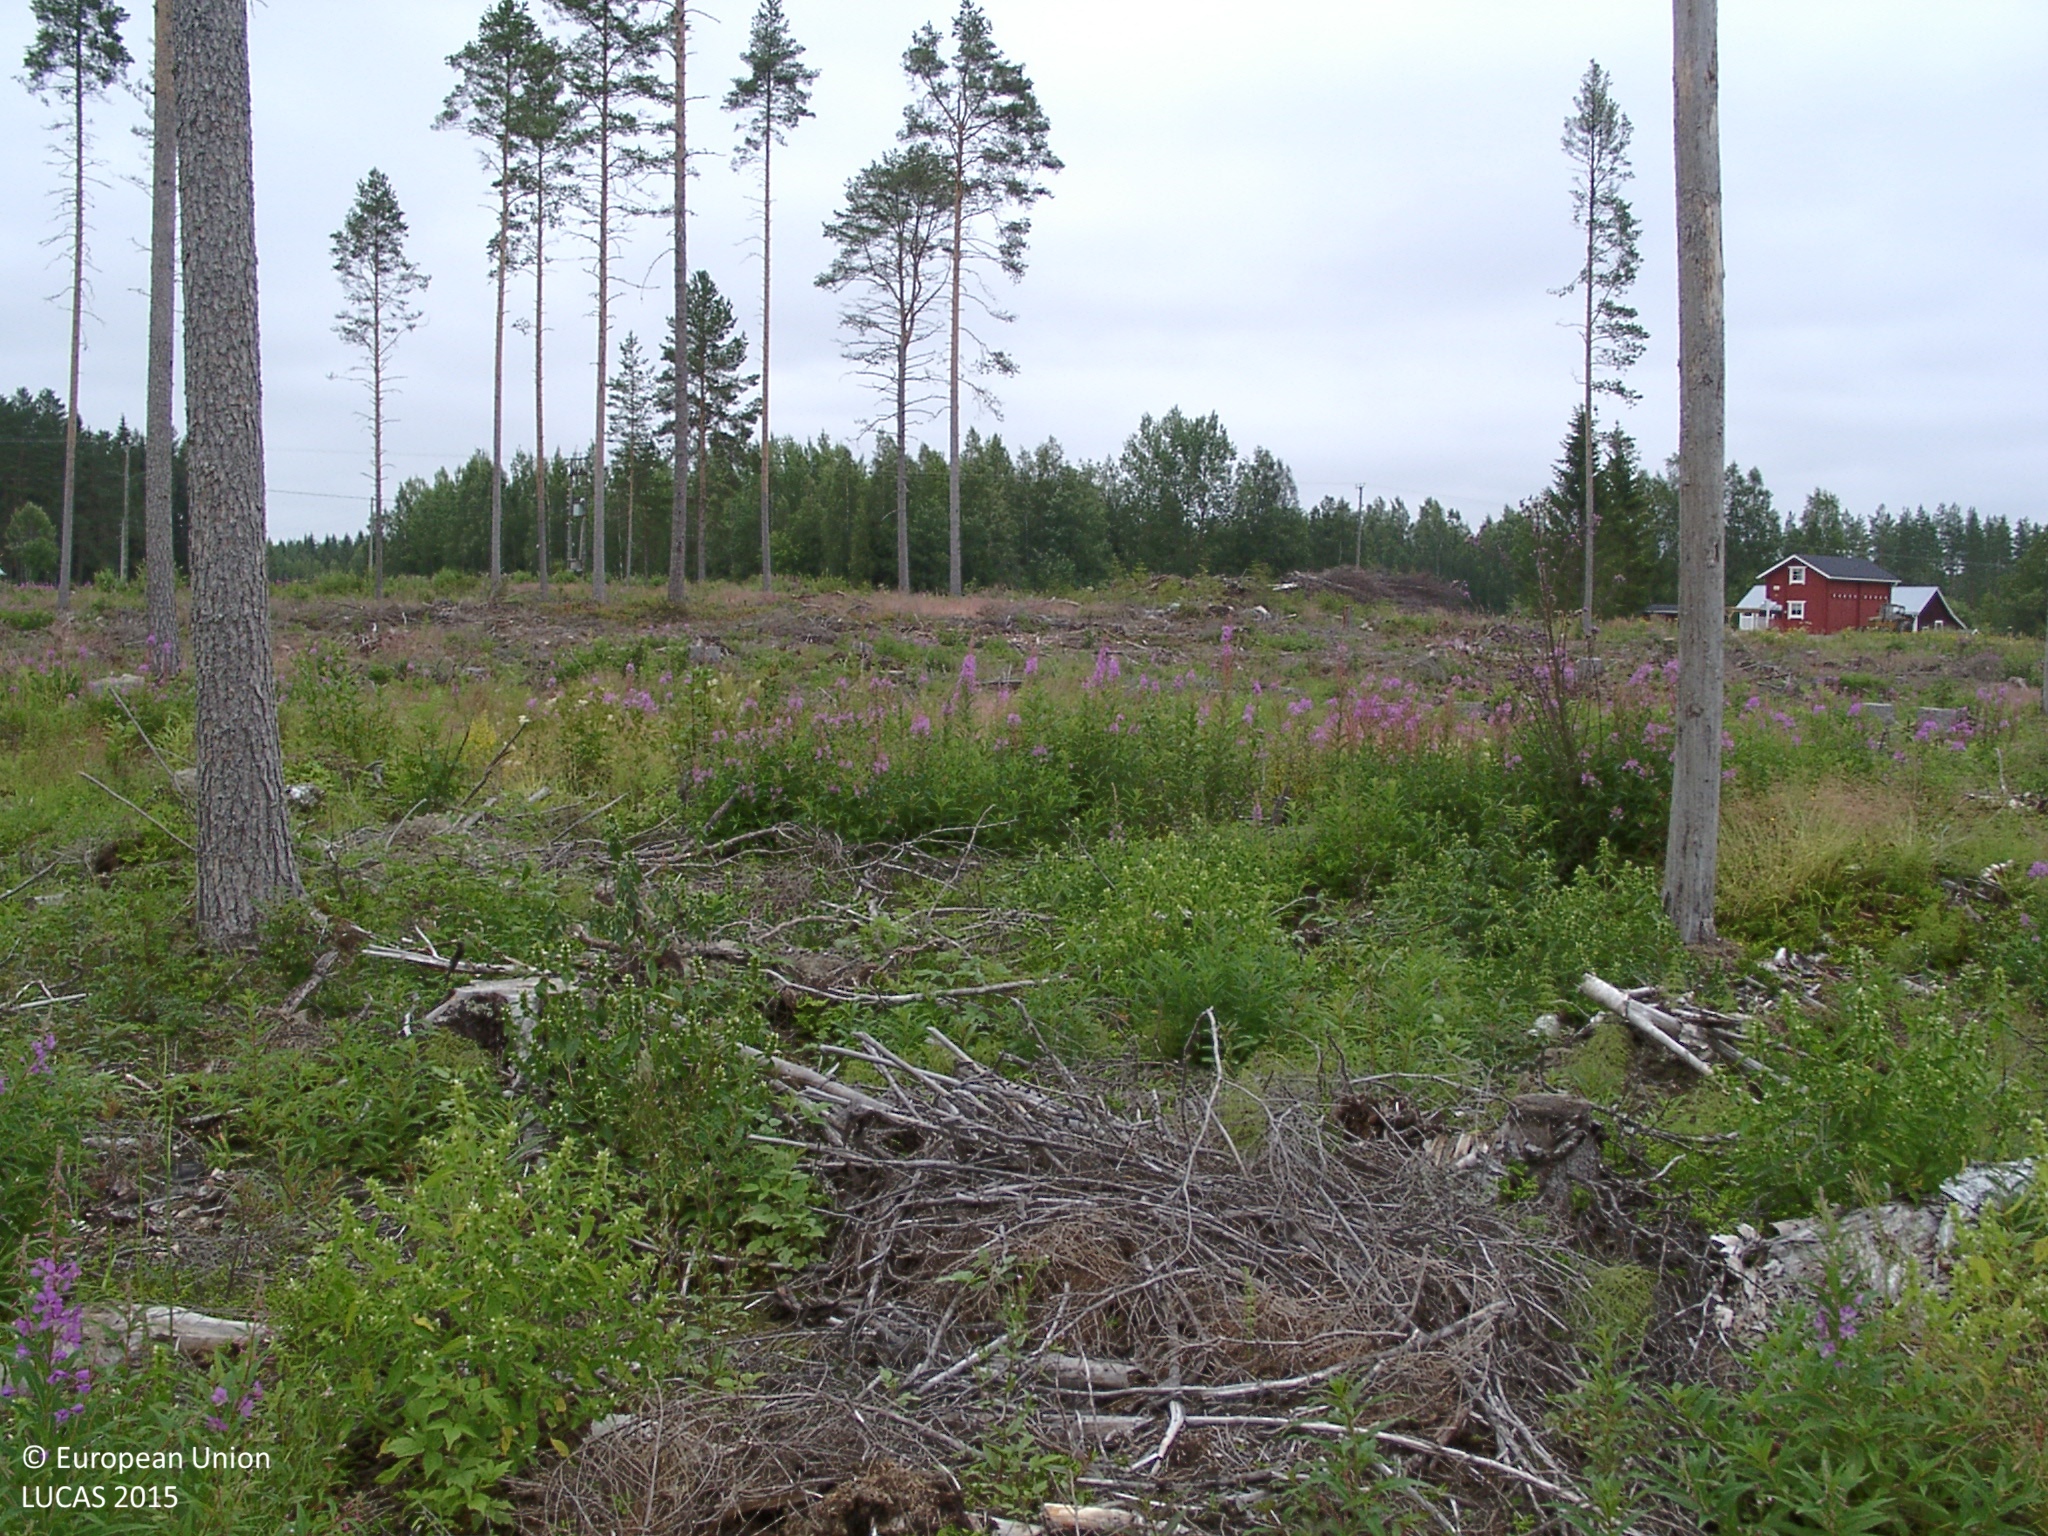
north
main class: Grassland
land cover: Grassland without tree/shrub cover
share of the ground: 50 - 75 %
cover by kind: herbaceous plants 50 %, unconsolidated bare surface 20 %, shrubs 5 %, lichens and mosses 5 %
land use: Forestry
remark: Clear cut
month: August
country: FI
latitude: 62.8830
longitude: 24.6611
